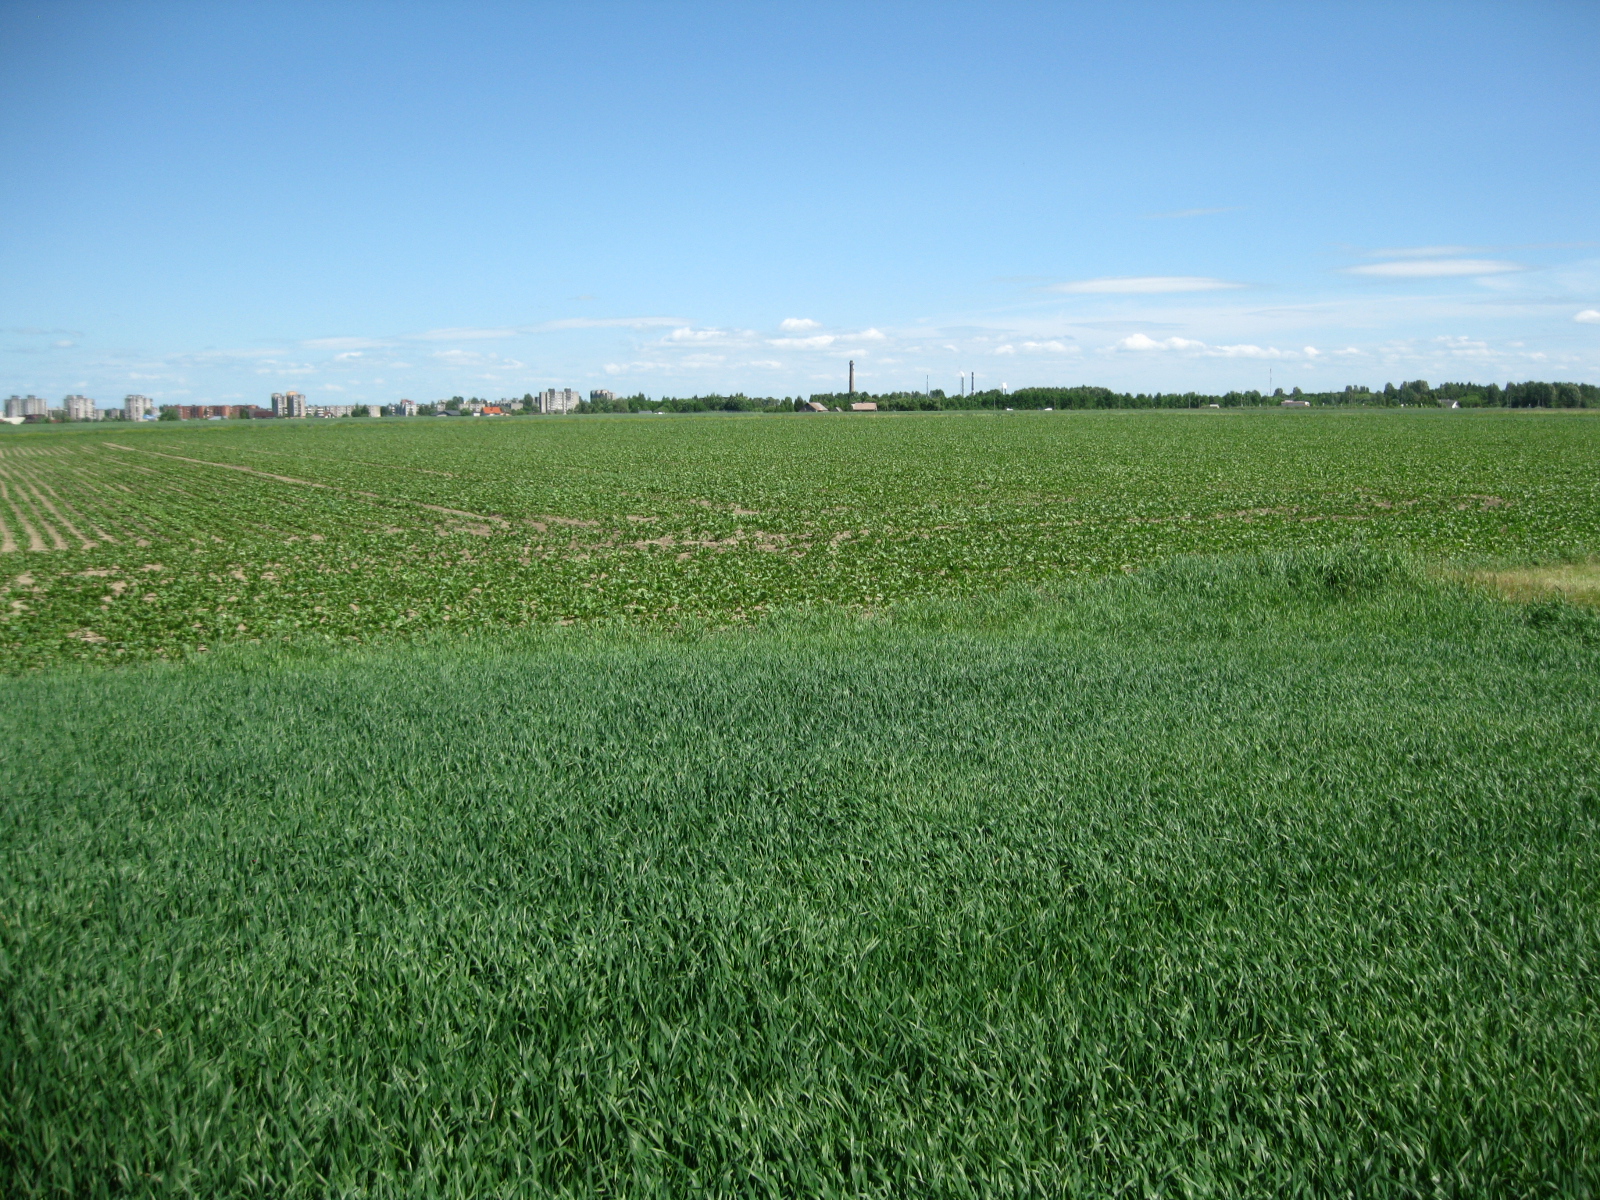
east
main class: Cropland
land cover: Triticale
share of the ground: > 75 %
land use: Agriculture (excluding fallow land and kitchen gardens)
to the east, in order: Triticale; Grass margins; Sugar beet; Grass margins; Tracks; Grass margins; Common wheat
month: June
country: LT
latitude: 55.2771
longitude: 23.9254
